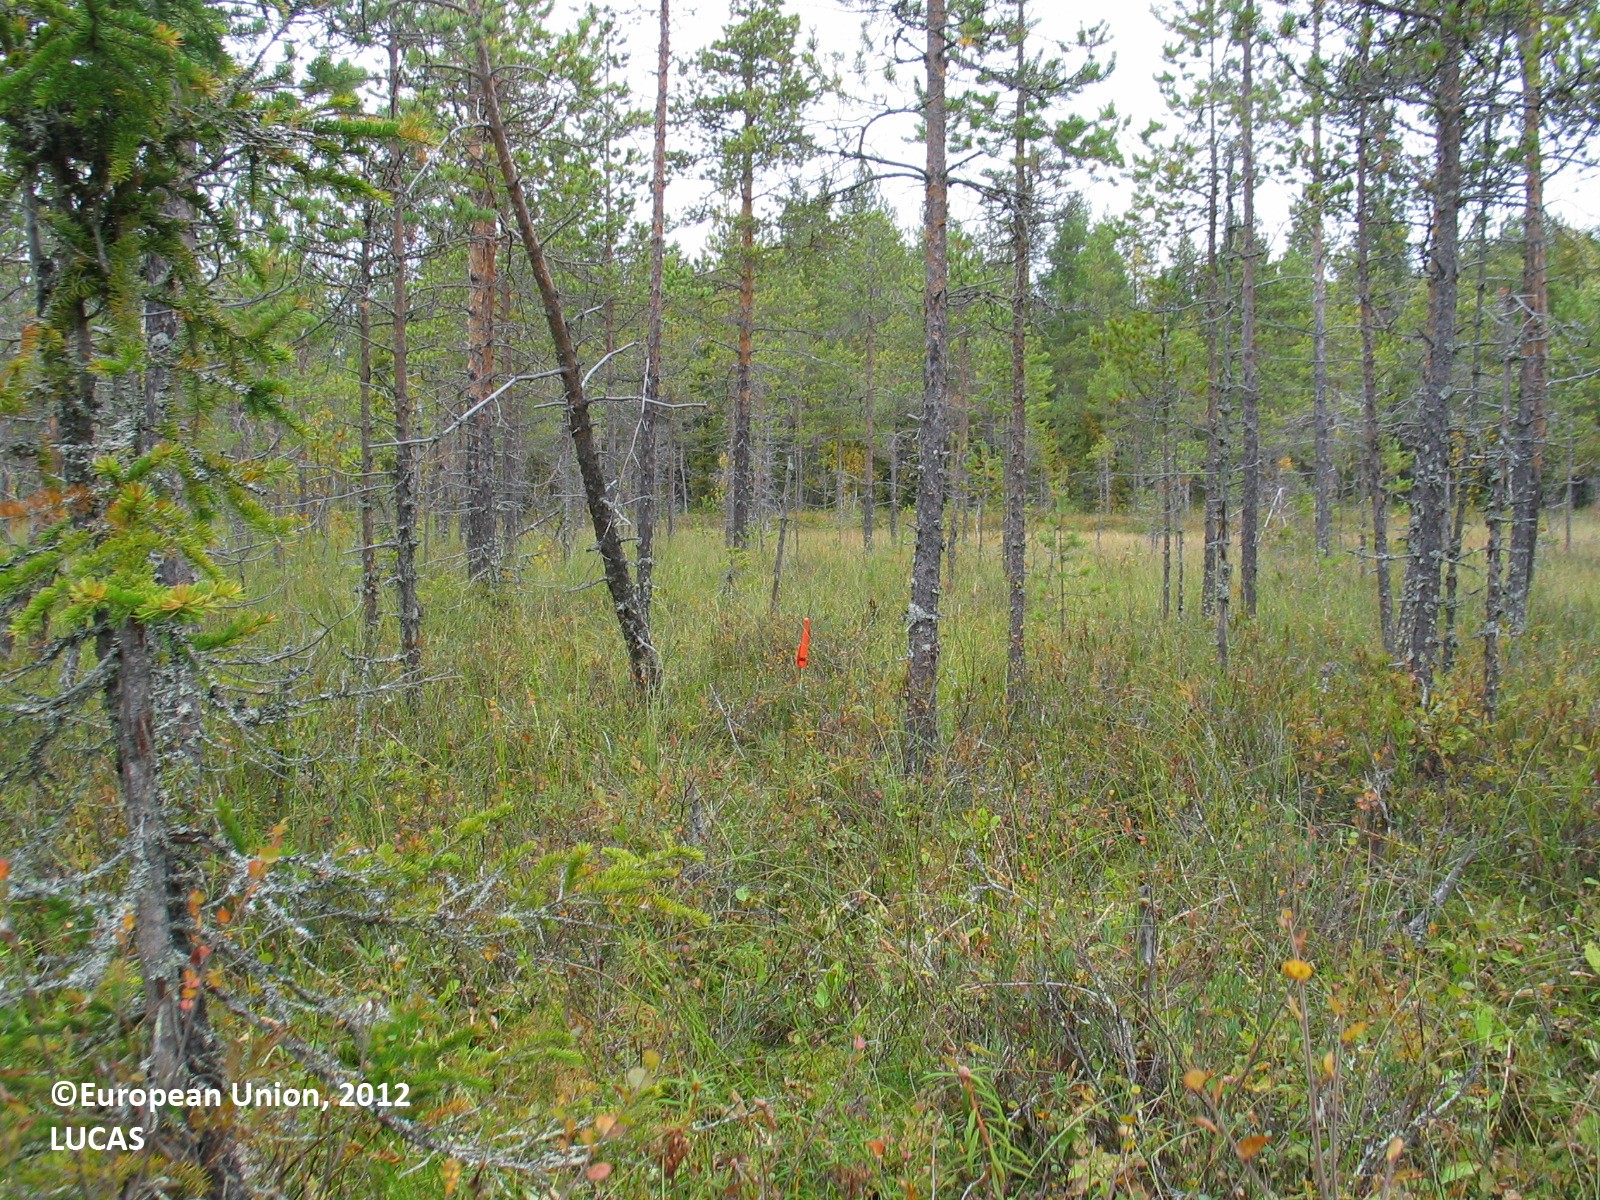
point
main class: Woodland
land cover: Pine dominated coniferous woodland
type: mire and swamp forests
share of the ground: 25 - 50 %
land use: Forestry
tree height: > 5 m
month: September
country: FI
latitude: 65.6053
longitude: 25.1492
